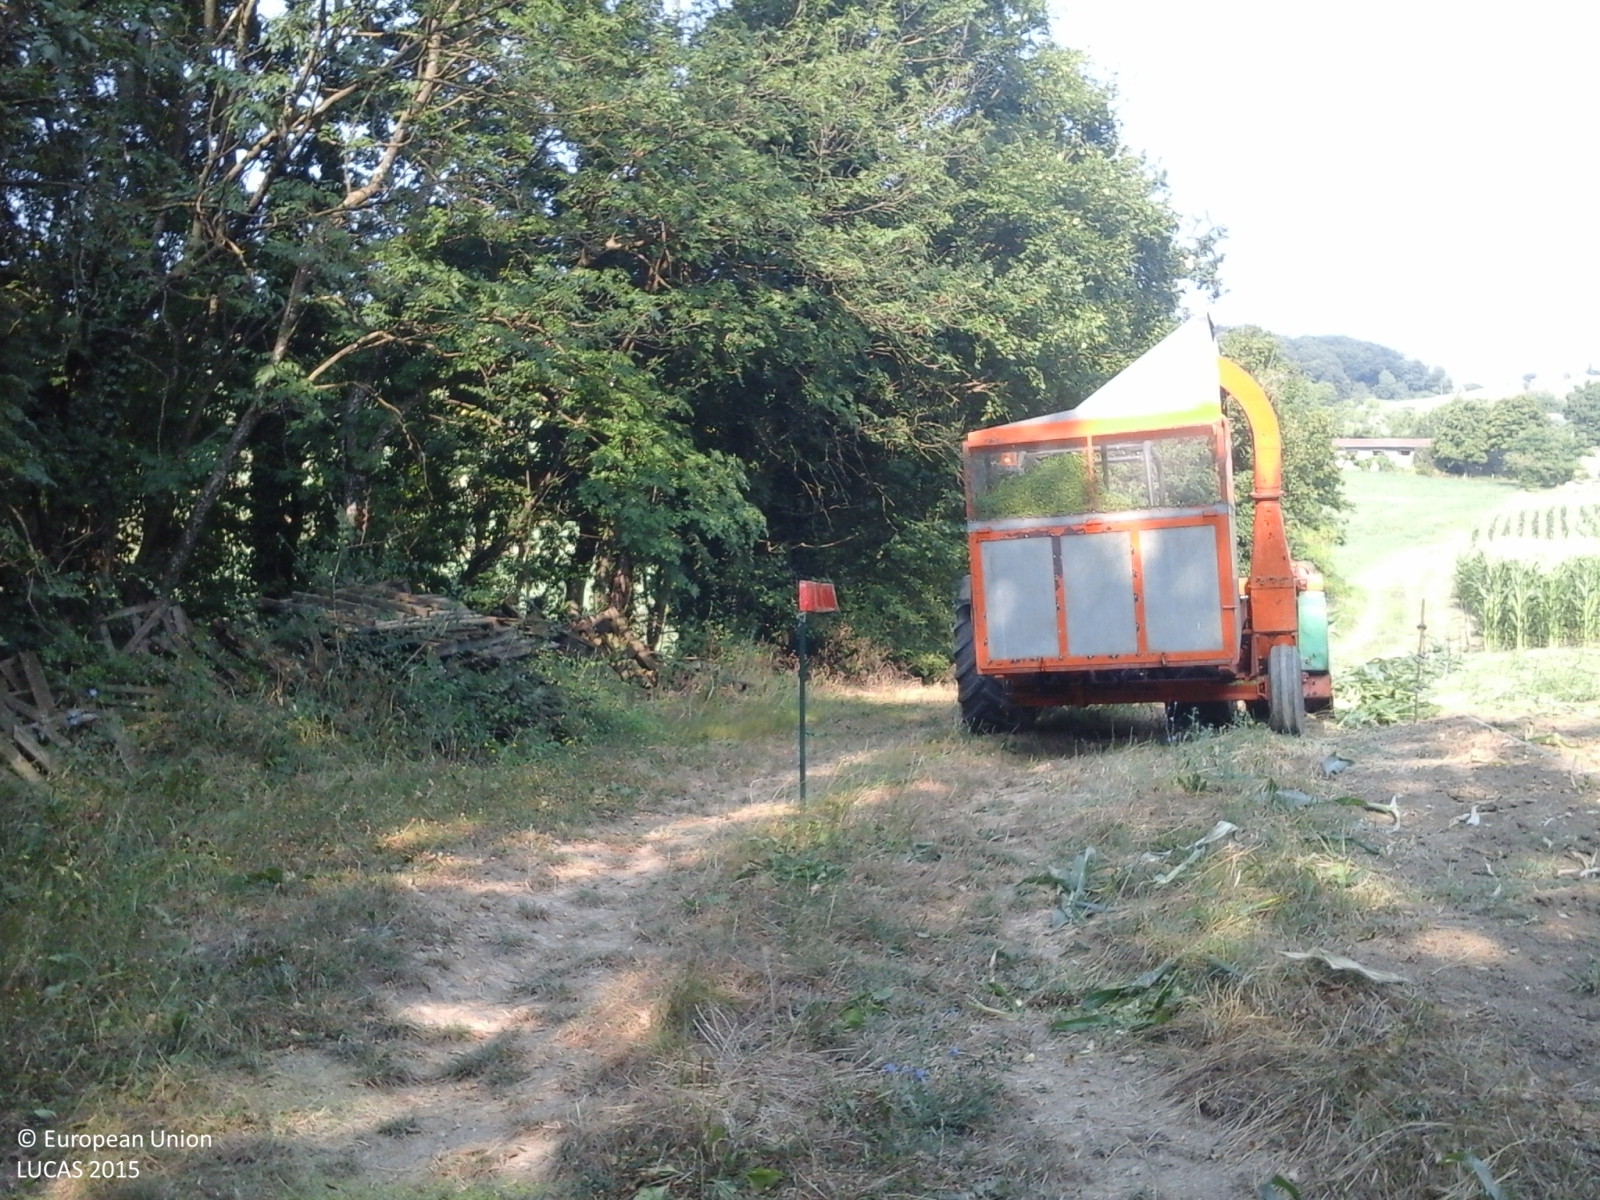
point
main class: Cropland
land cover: Maize
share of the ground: > 75 %
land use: Agriculture (excluding fallow land and kitchen gardens)
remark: Harvested field
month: July
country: IT
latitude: 44.3648
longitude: 10.8889
